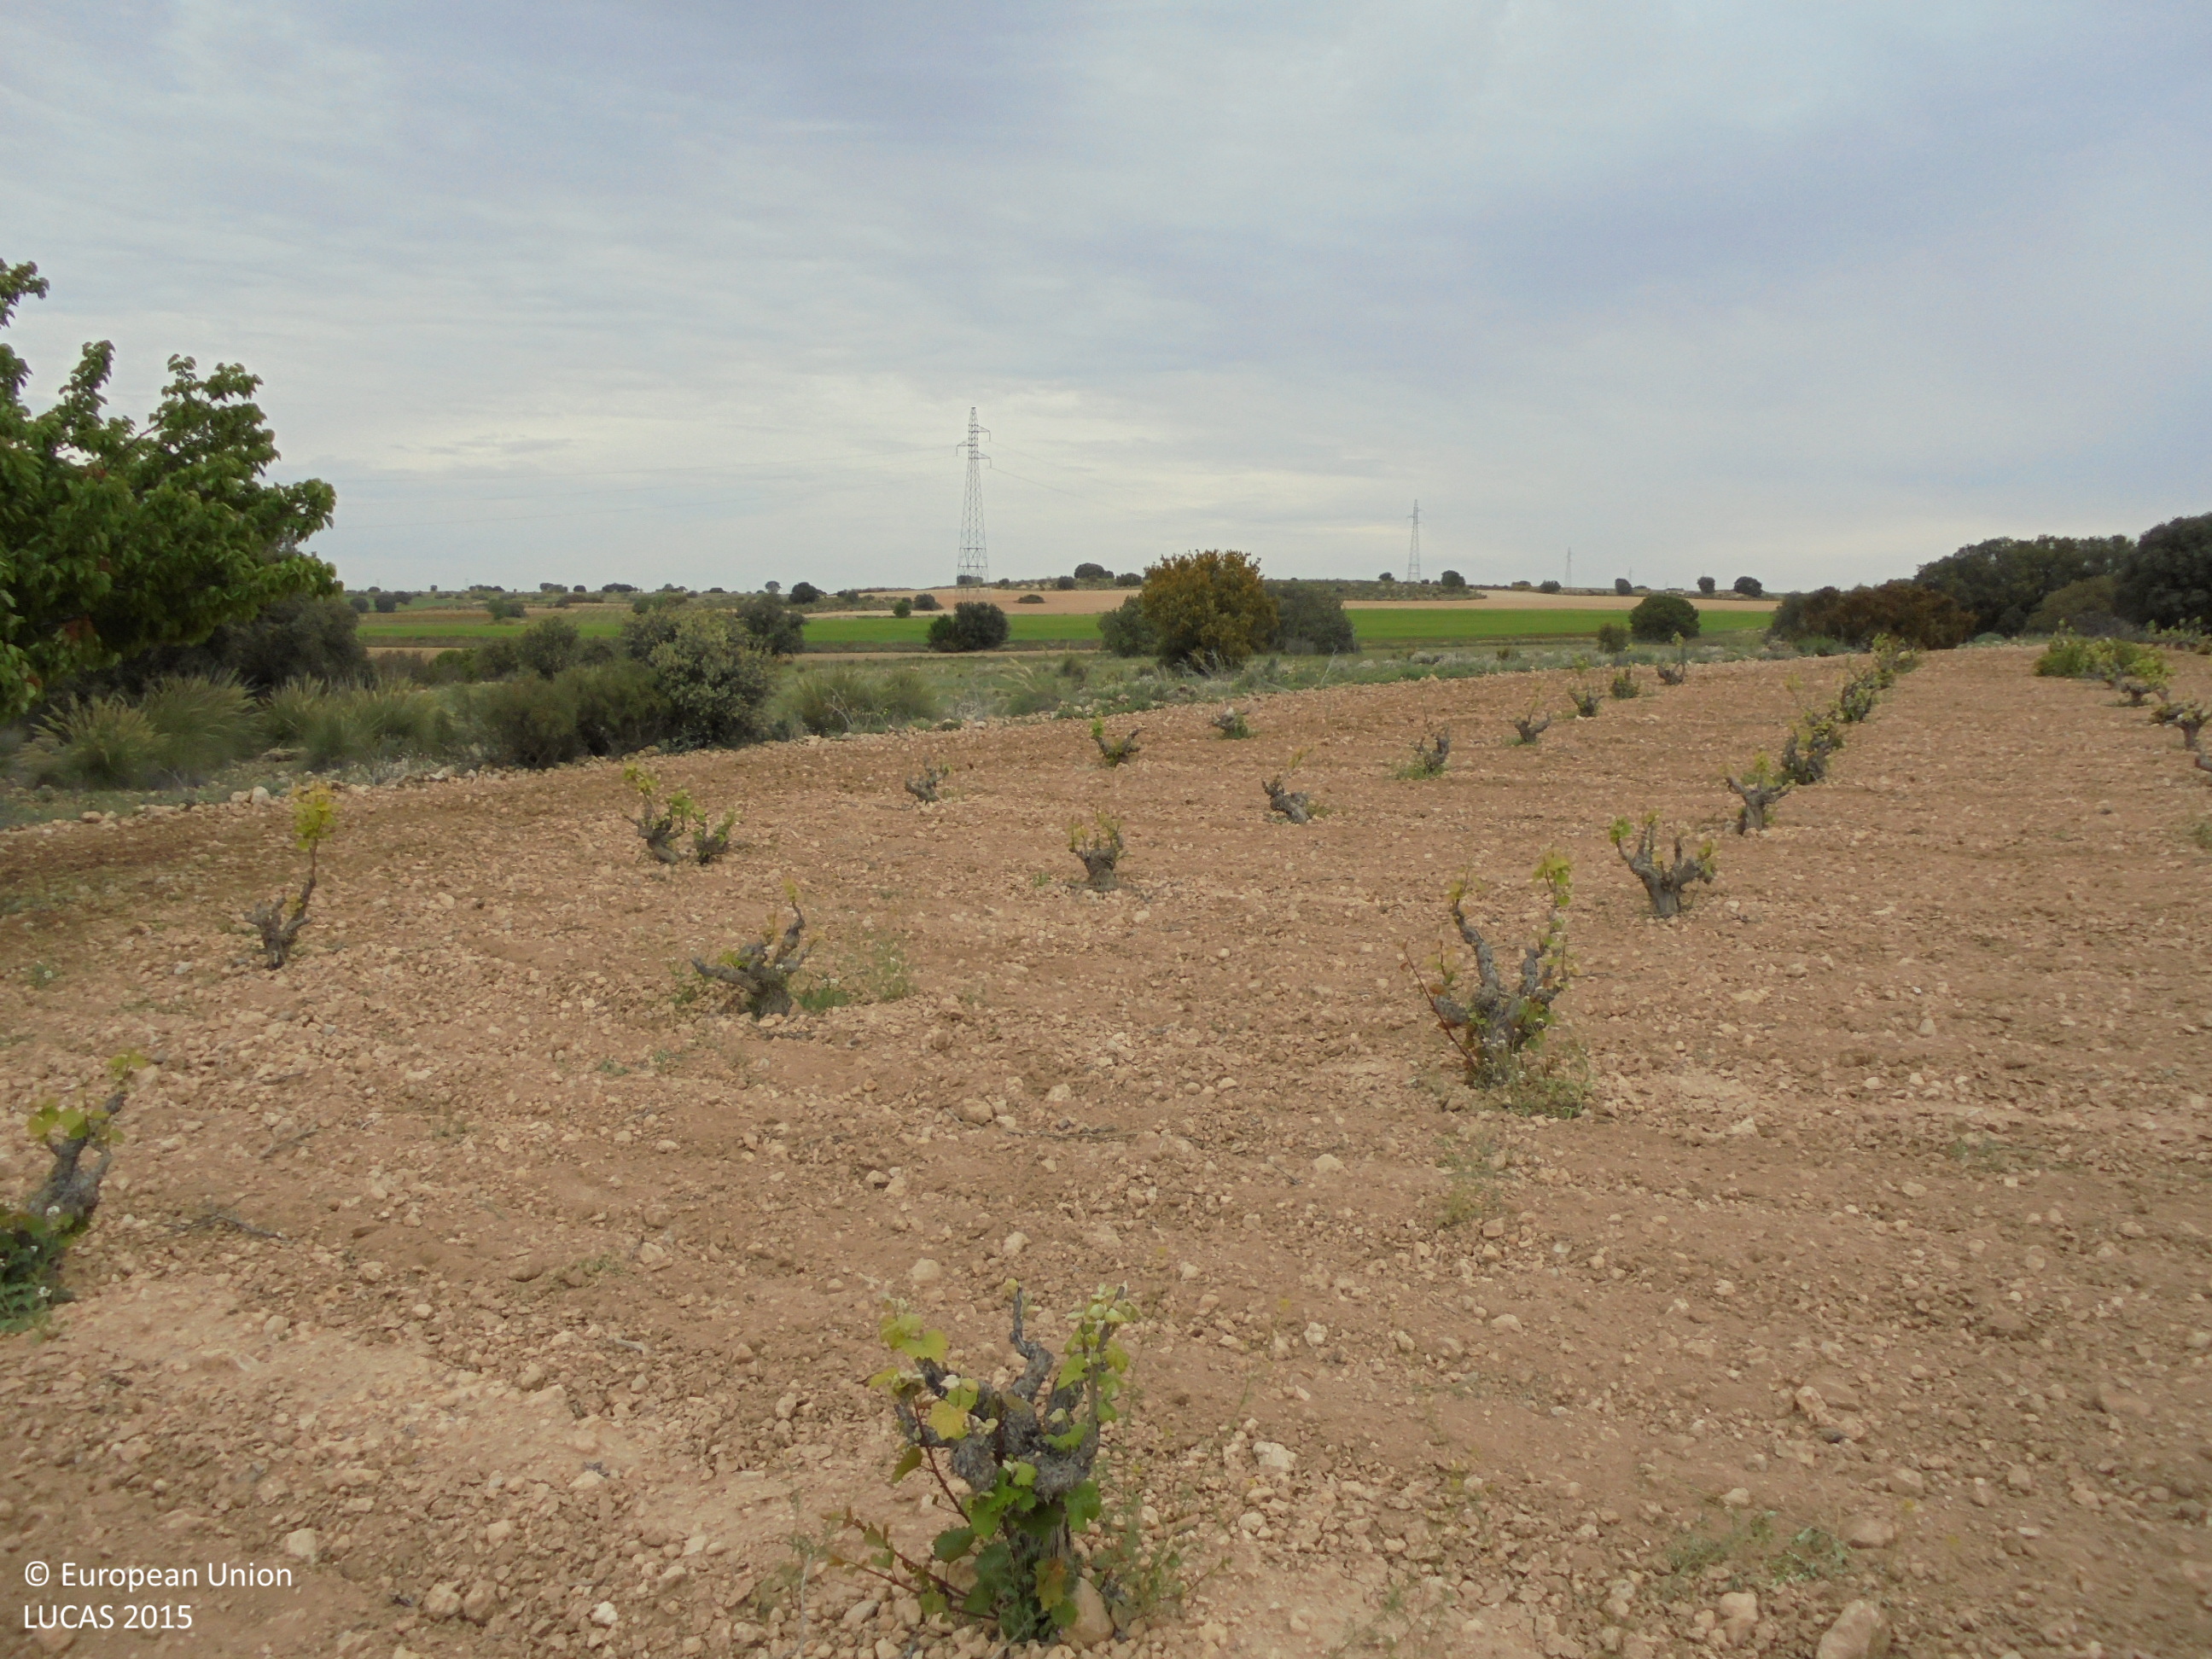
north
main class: Cropland
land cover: Vineyards
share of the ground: < 10 %
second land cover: Other bare soil
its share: > 75 %
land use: Agriculture (excluding fallow land and kitchen gardens)
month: May
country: ES
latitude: 39.1928
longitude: -1.7540
